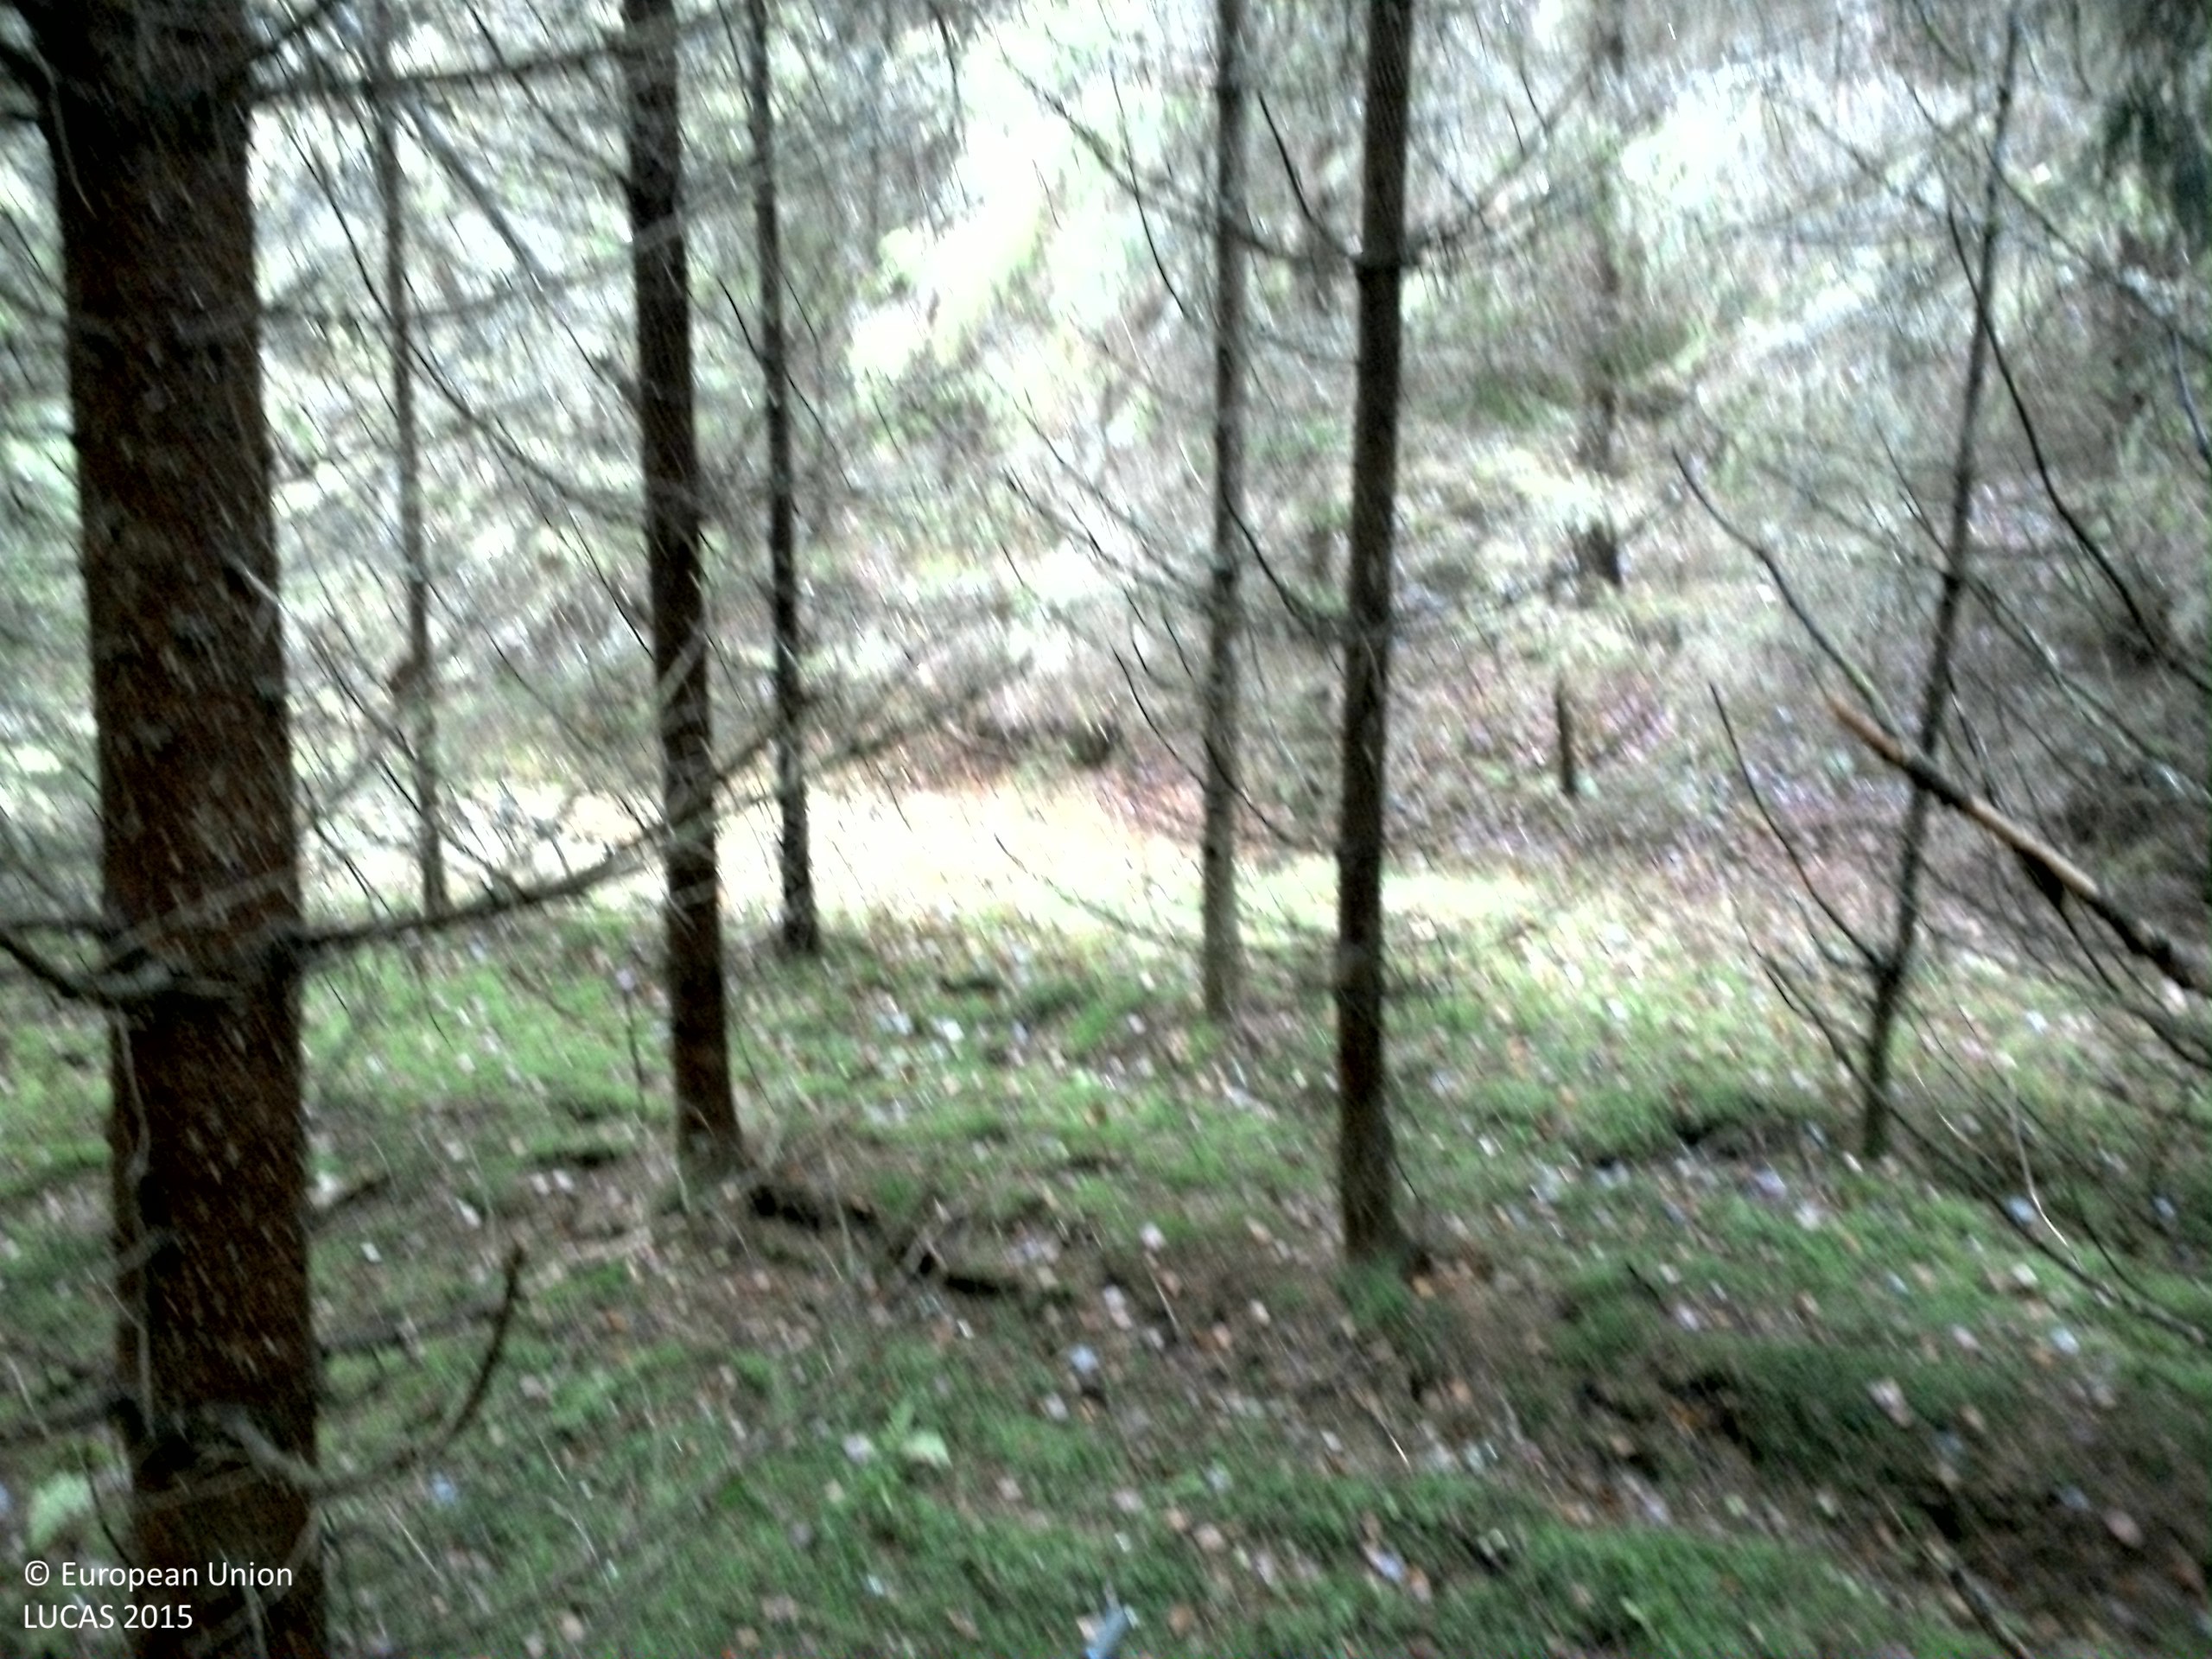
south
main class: Woodland
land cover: Spruce dominated coniferous woodland
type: boreal forest
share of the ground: > 75 %
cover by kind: coniferous forest trees 75 %, lichens and mosses 20 %, shrubs 5 %
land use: Forestry
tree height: > 5 m
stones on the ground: < 10 %
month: November
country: SE
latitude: 57.6930
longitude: 15.4820
